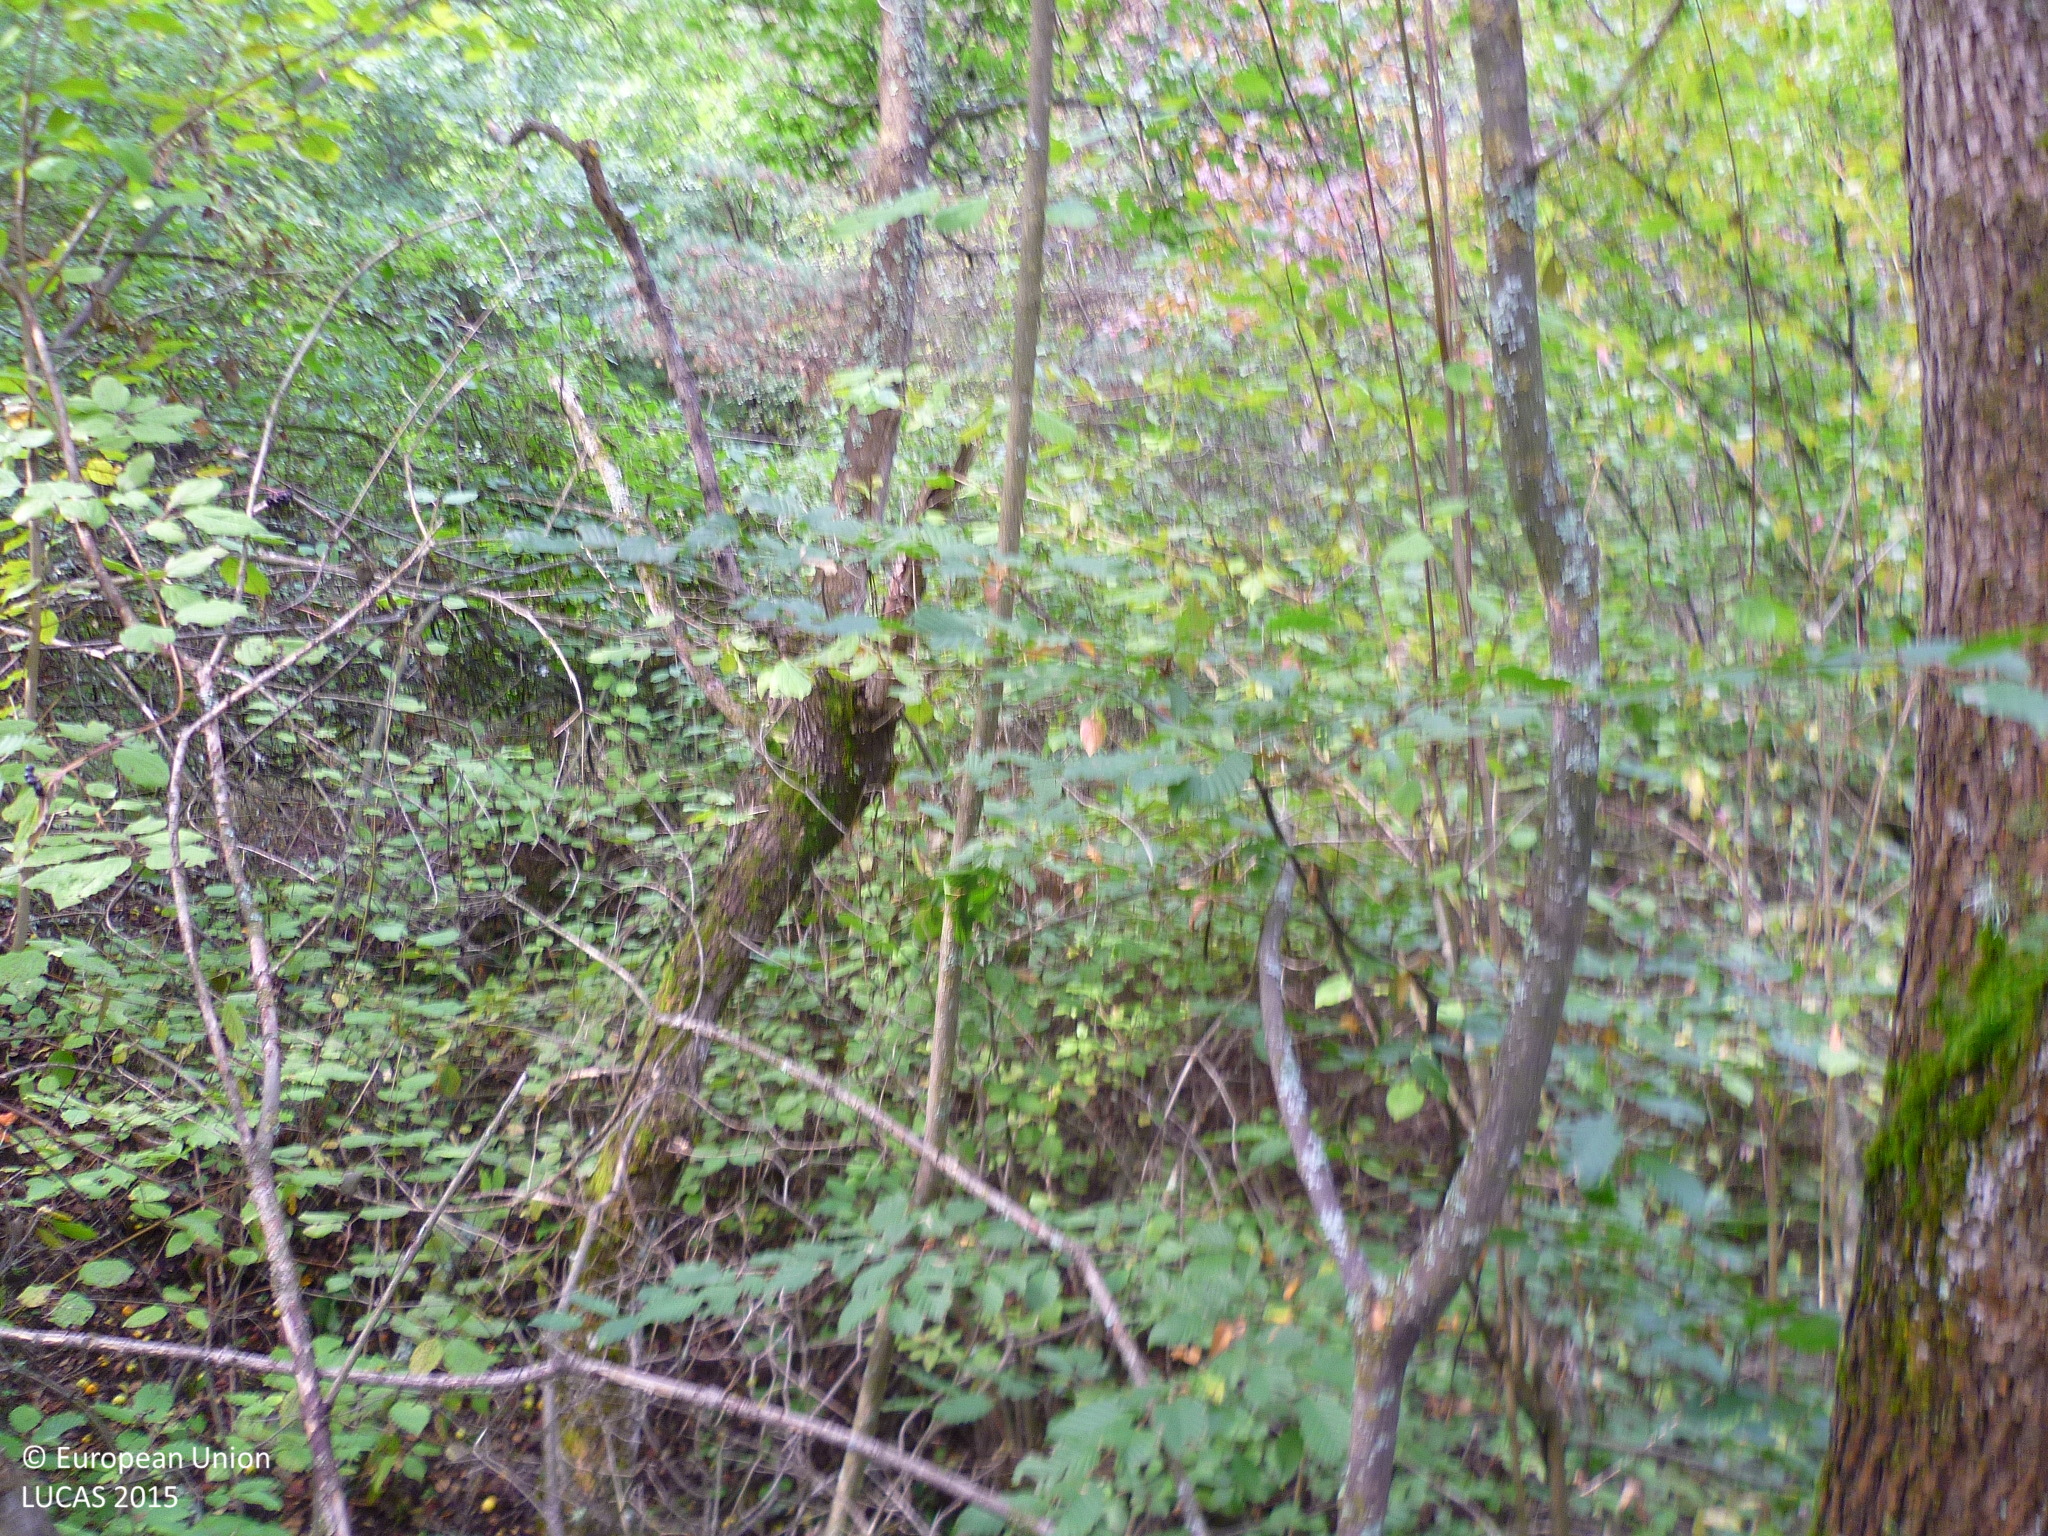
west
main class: Woodland
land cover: Broadleaved woodland
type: mesophytic deciduous forest
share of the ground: > 75 %
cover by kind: broadleaved forest trees 80 %, herbaceous plants 20 %
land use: Semi-natural and natural areas not in use
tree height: > 5 m
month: September
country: BG
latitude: 42.8283
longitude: 22.9109
